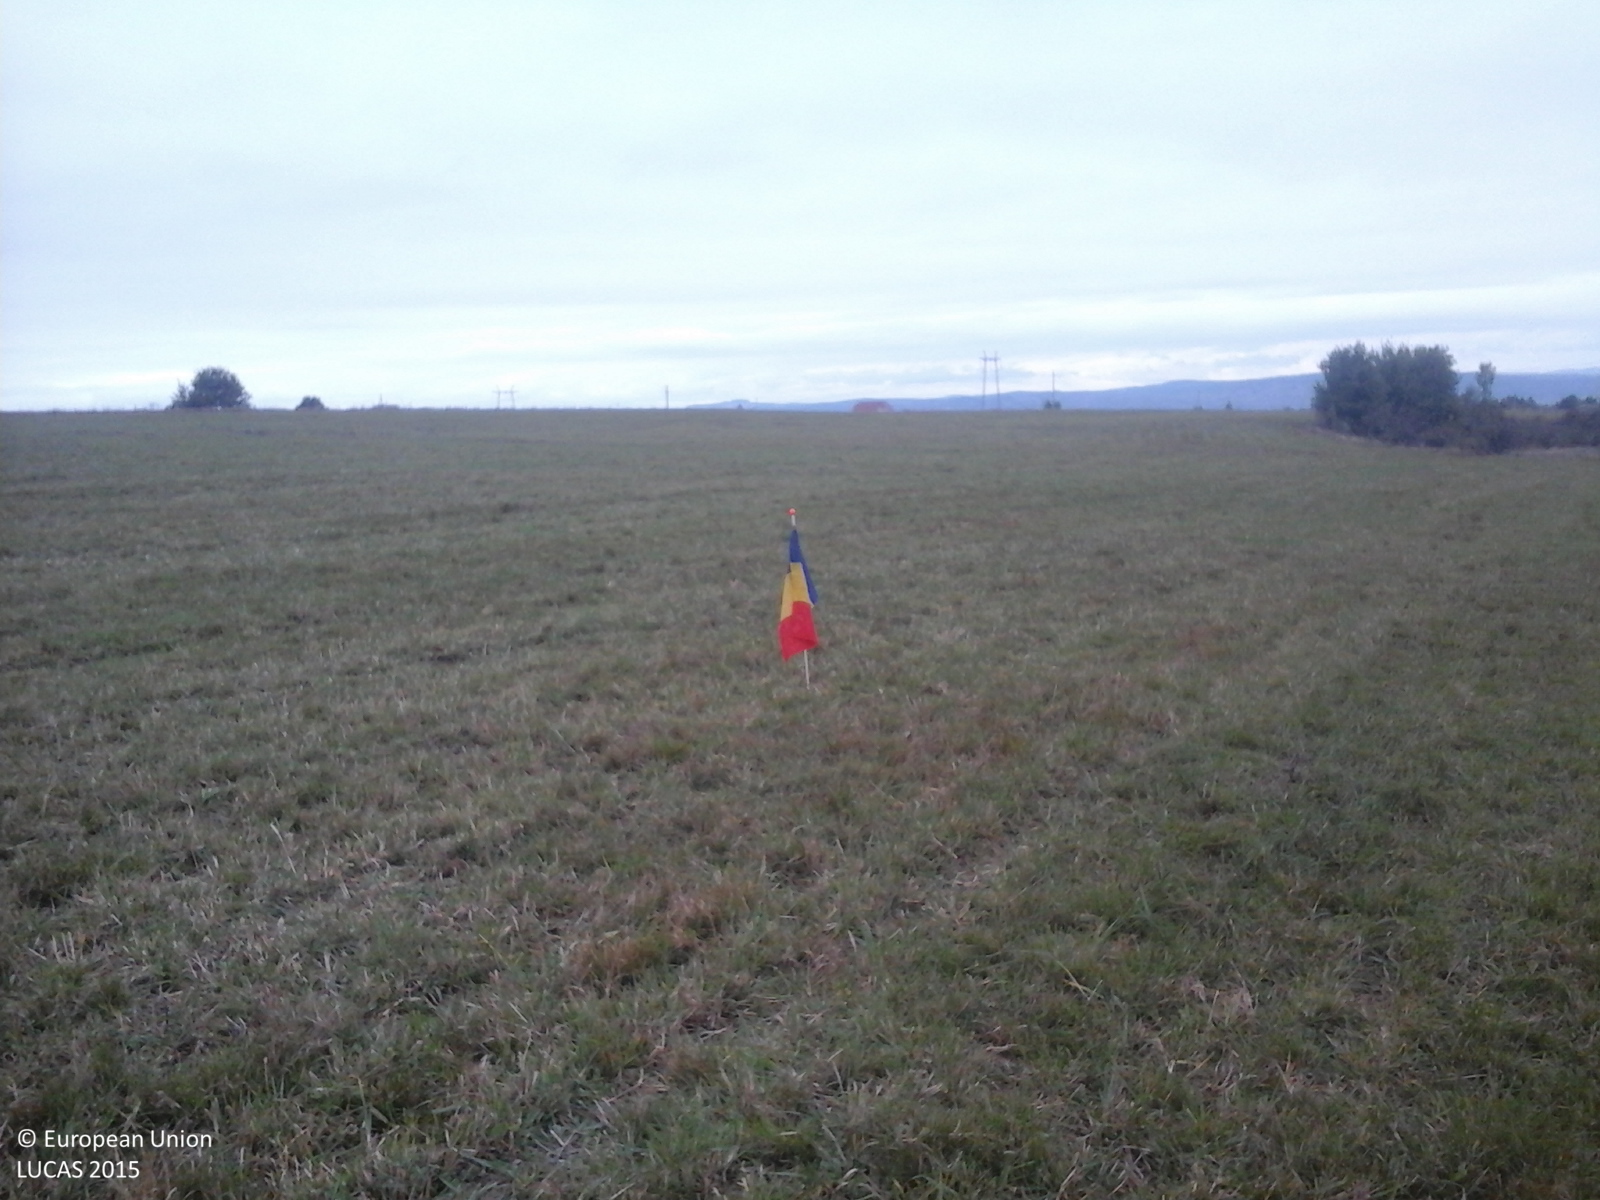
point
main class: Grassland
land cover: Grassland without tree/shrub cover
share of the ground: > 75 %
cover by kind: herbaceous plants 100 %
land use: Agriculture (excluding fallow land and kitchen gardens)
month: October
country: RO
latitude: 45.7282
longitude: 24.7215
